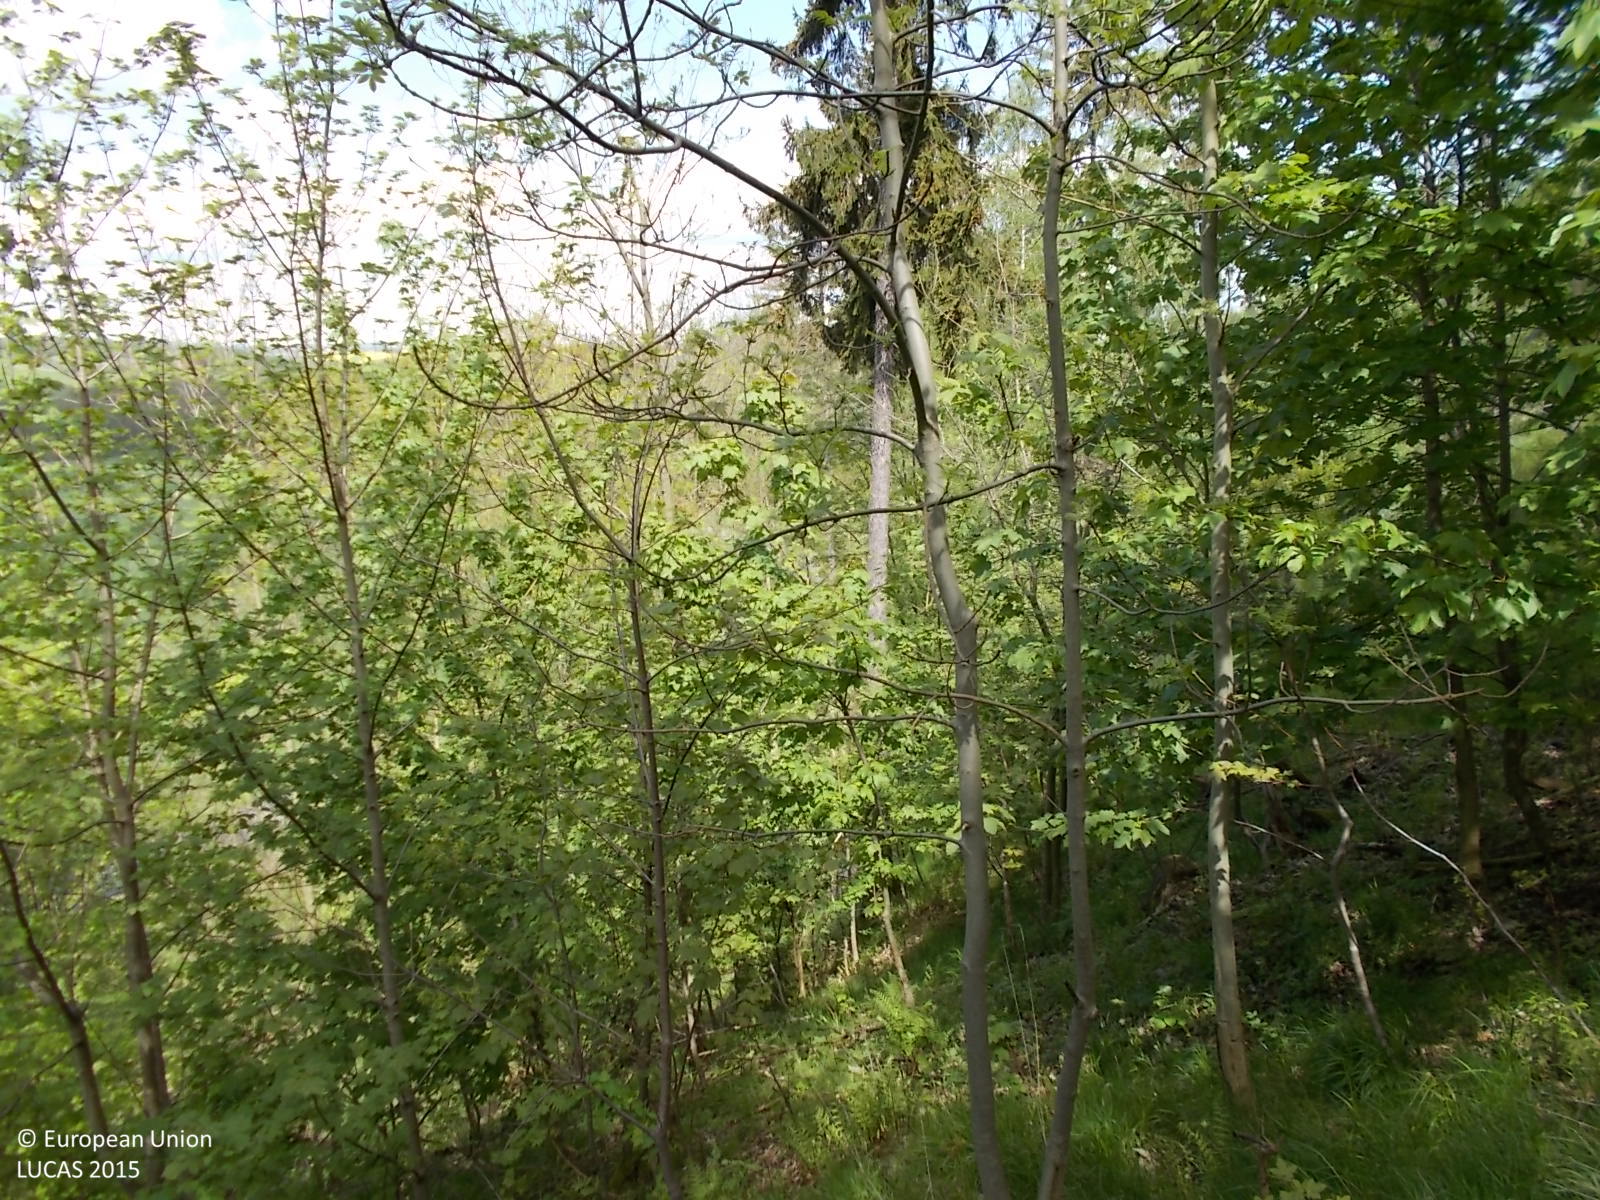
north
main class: Woodland
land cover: Spruce dominated mixed woodland
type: mesophytic deciduous forest
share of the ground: > 75 %
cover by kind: broadleaved forest trees 45 %, coniferous forest trees 25 %, herbaceous plants 15 %, shrubs 10 %, lichens and mosses 5 %
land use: Forestry
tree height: > 5 m
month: May
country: CZ
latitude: 49.8868
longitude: 17.7104
